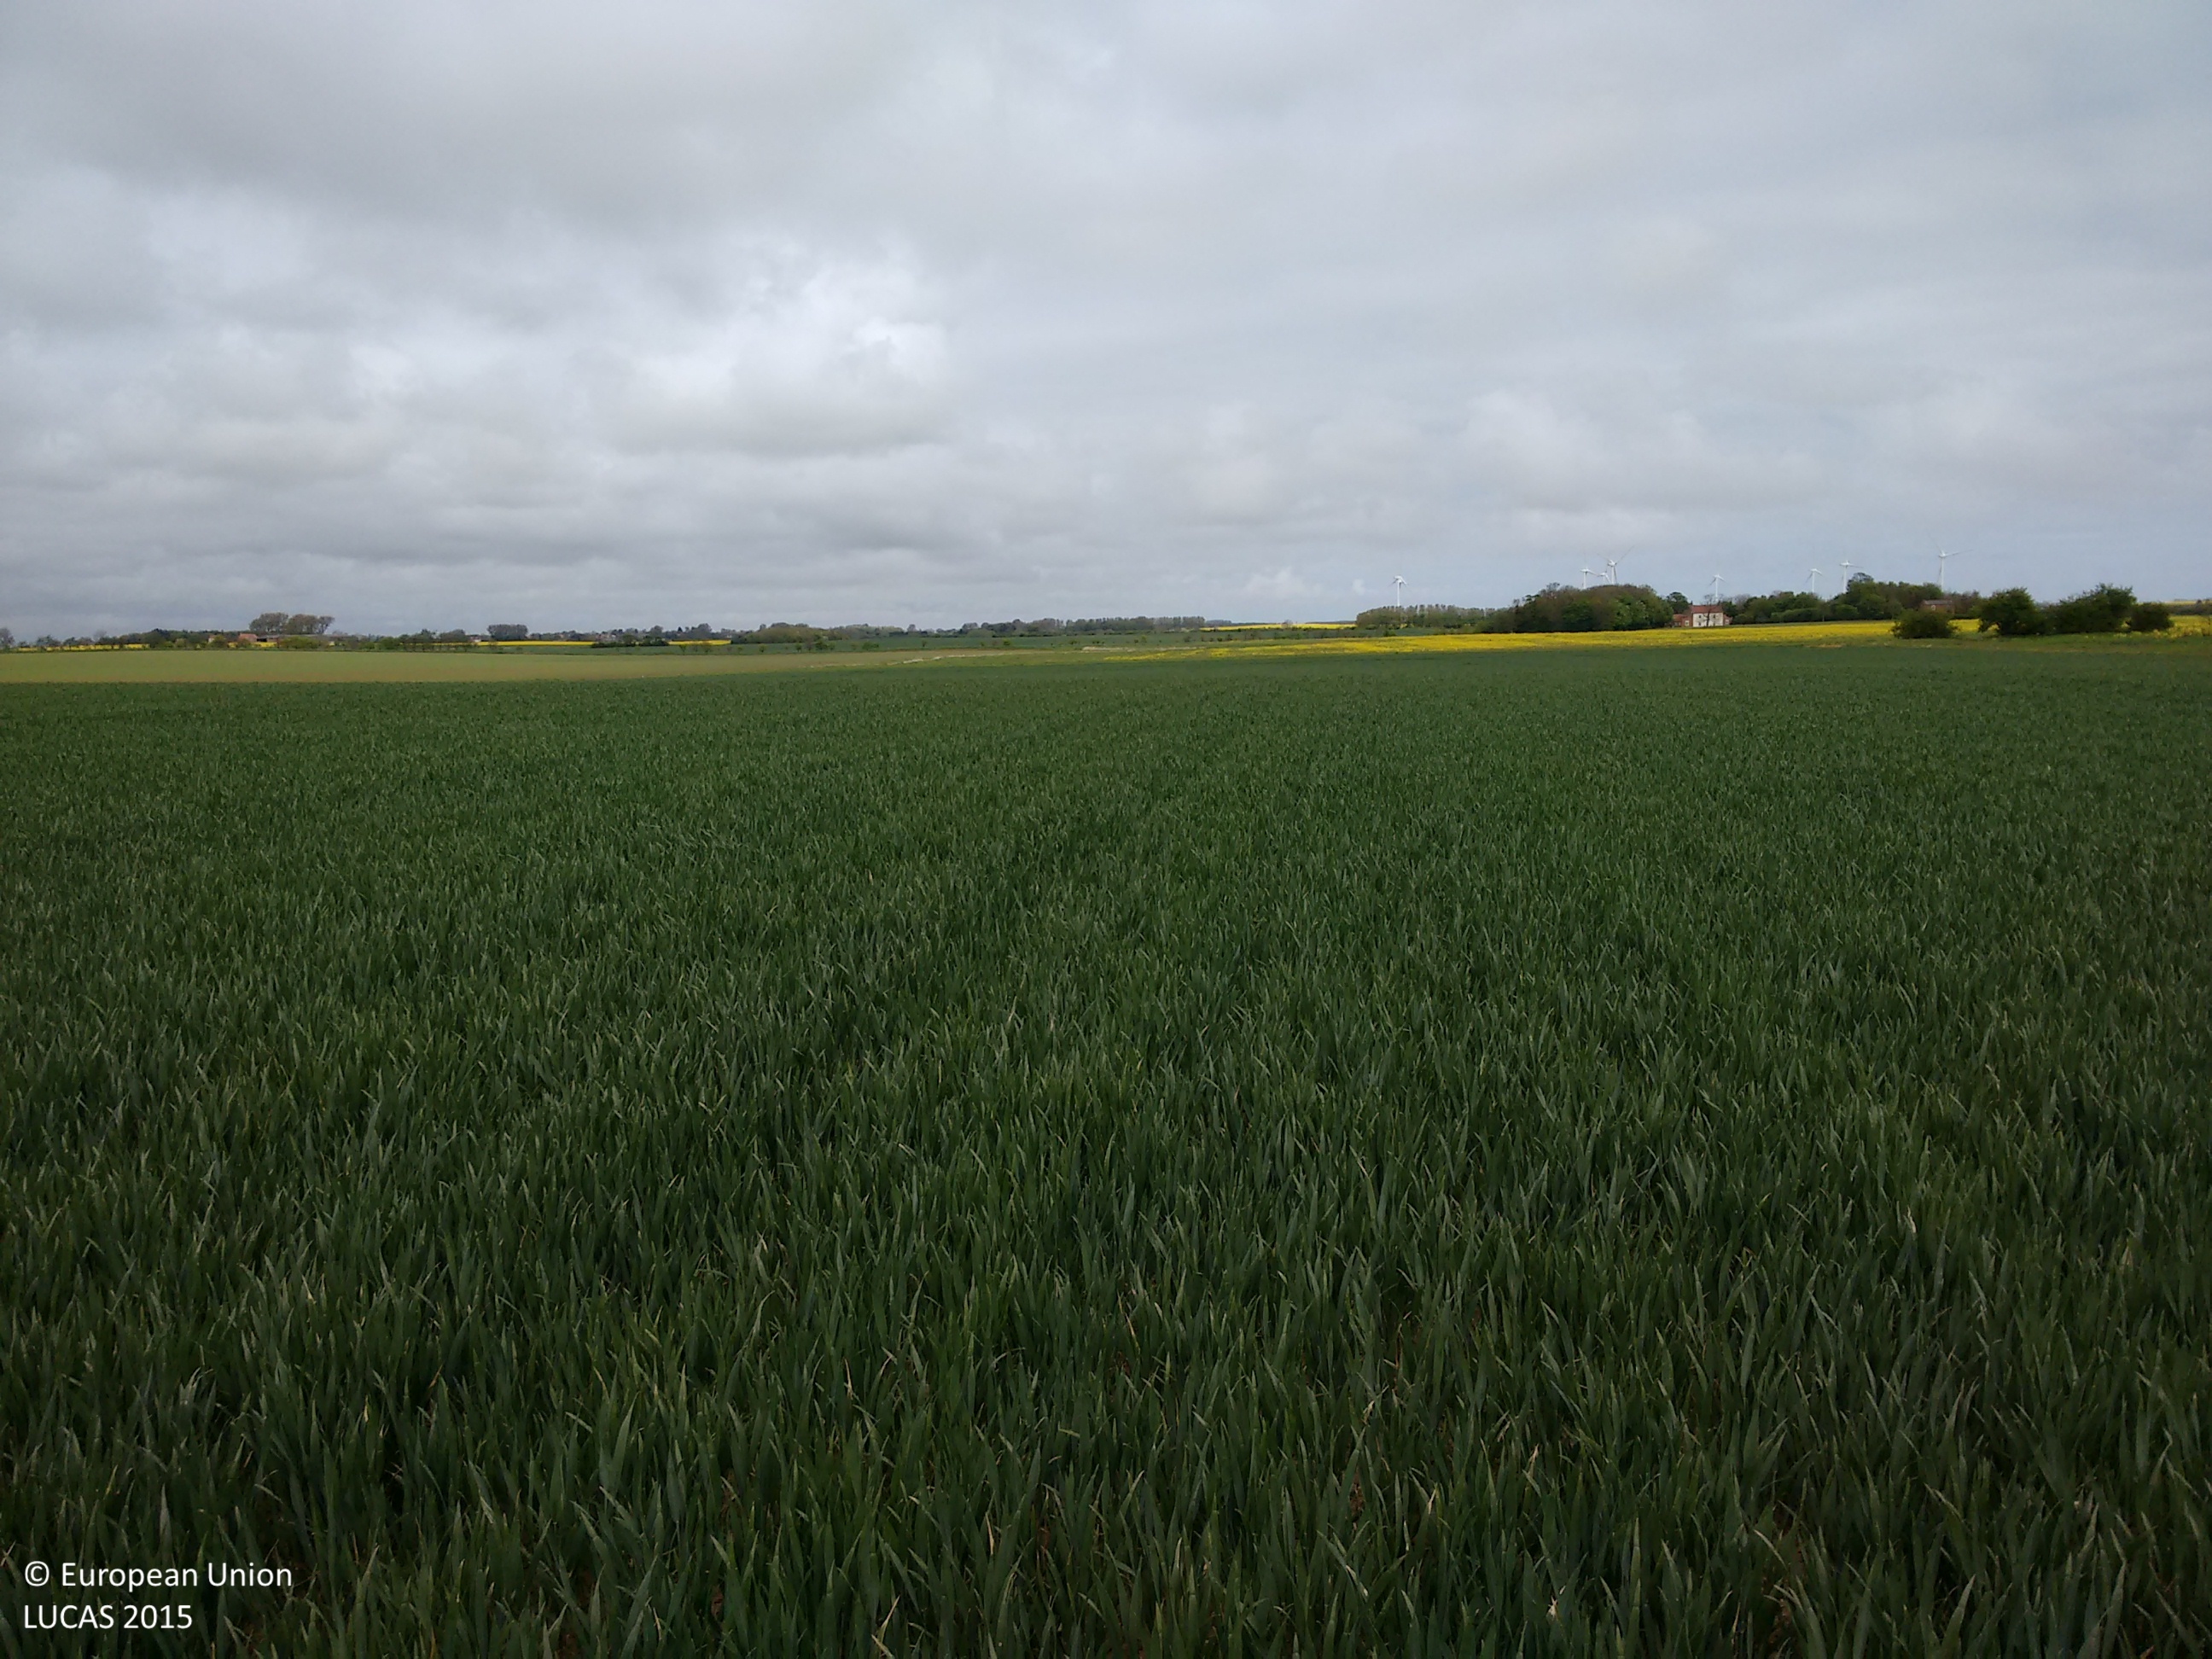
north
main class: Cropland
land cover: Common wheat
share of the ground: > 75 %
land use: Agriculture (excluding fallow land and kitchen gardens)
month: May
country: GB
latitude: 53.8249
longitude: -0.1661
